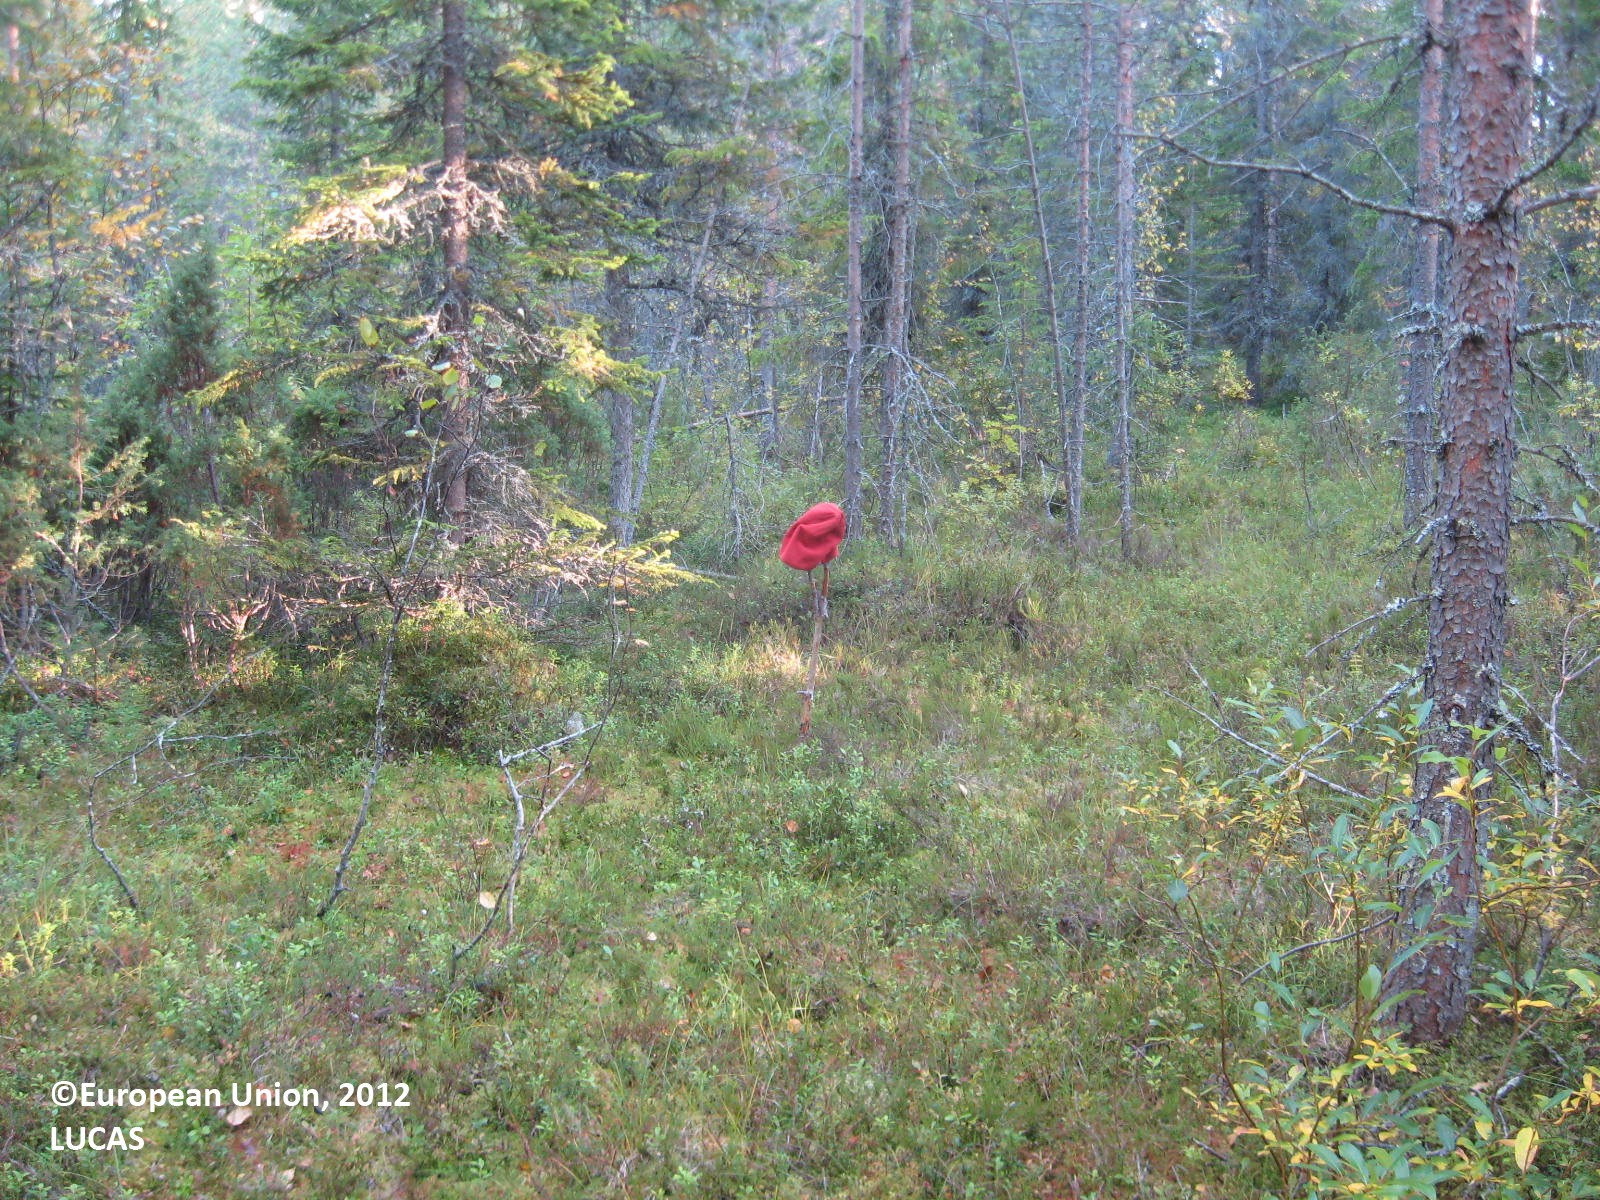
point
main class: Woodland
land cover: Pine dominated coniferous woodland
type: boreal forest
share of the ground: > 75 %
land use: Forestry
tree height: > 5 m
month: August
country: FI
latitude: 63.9506
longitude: 29.6790
